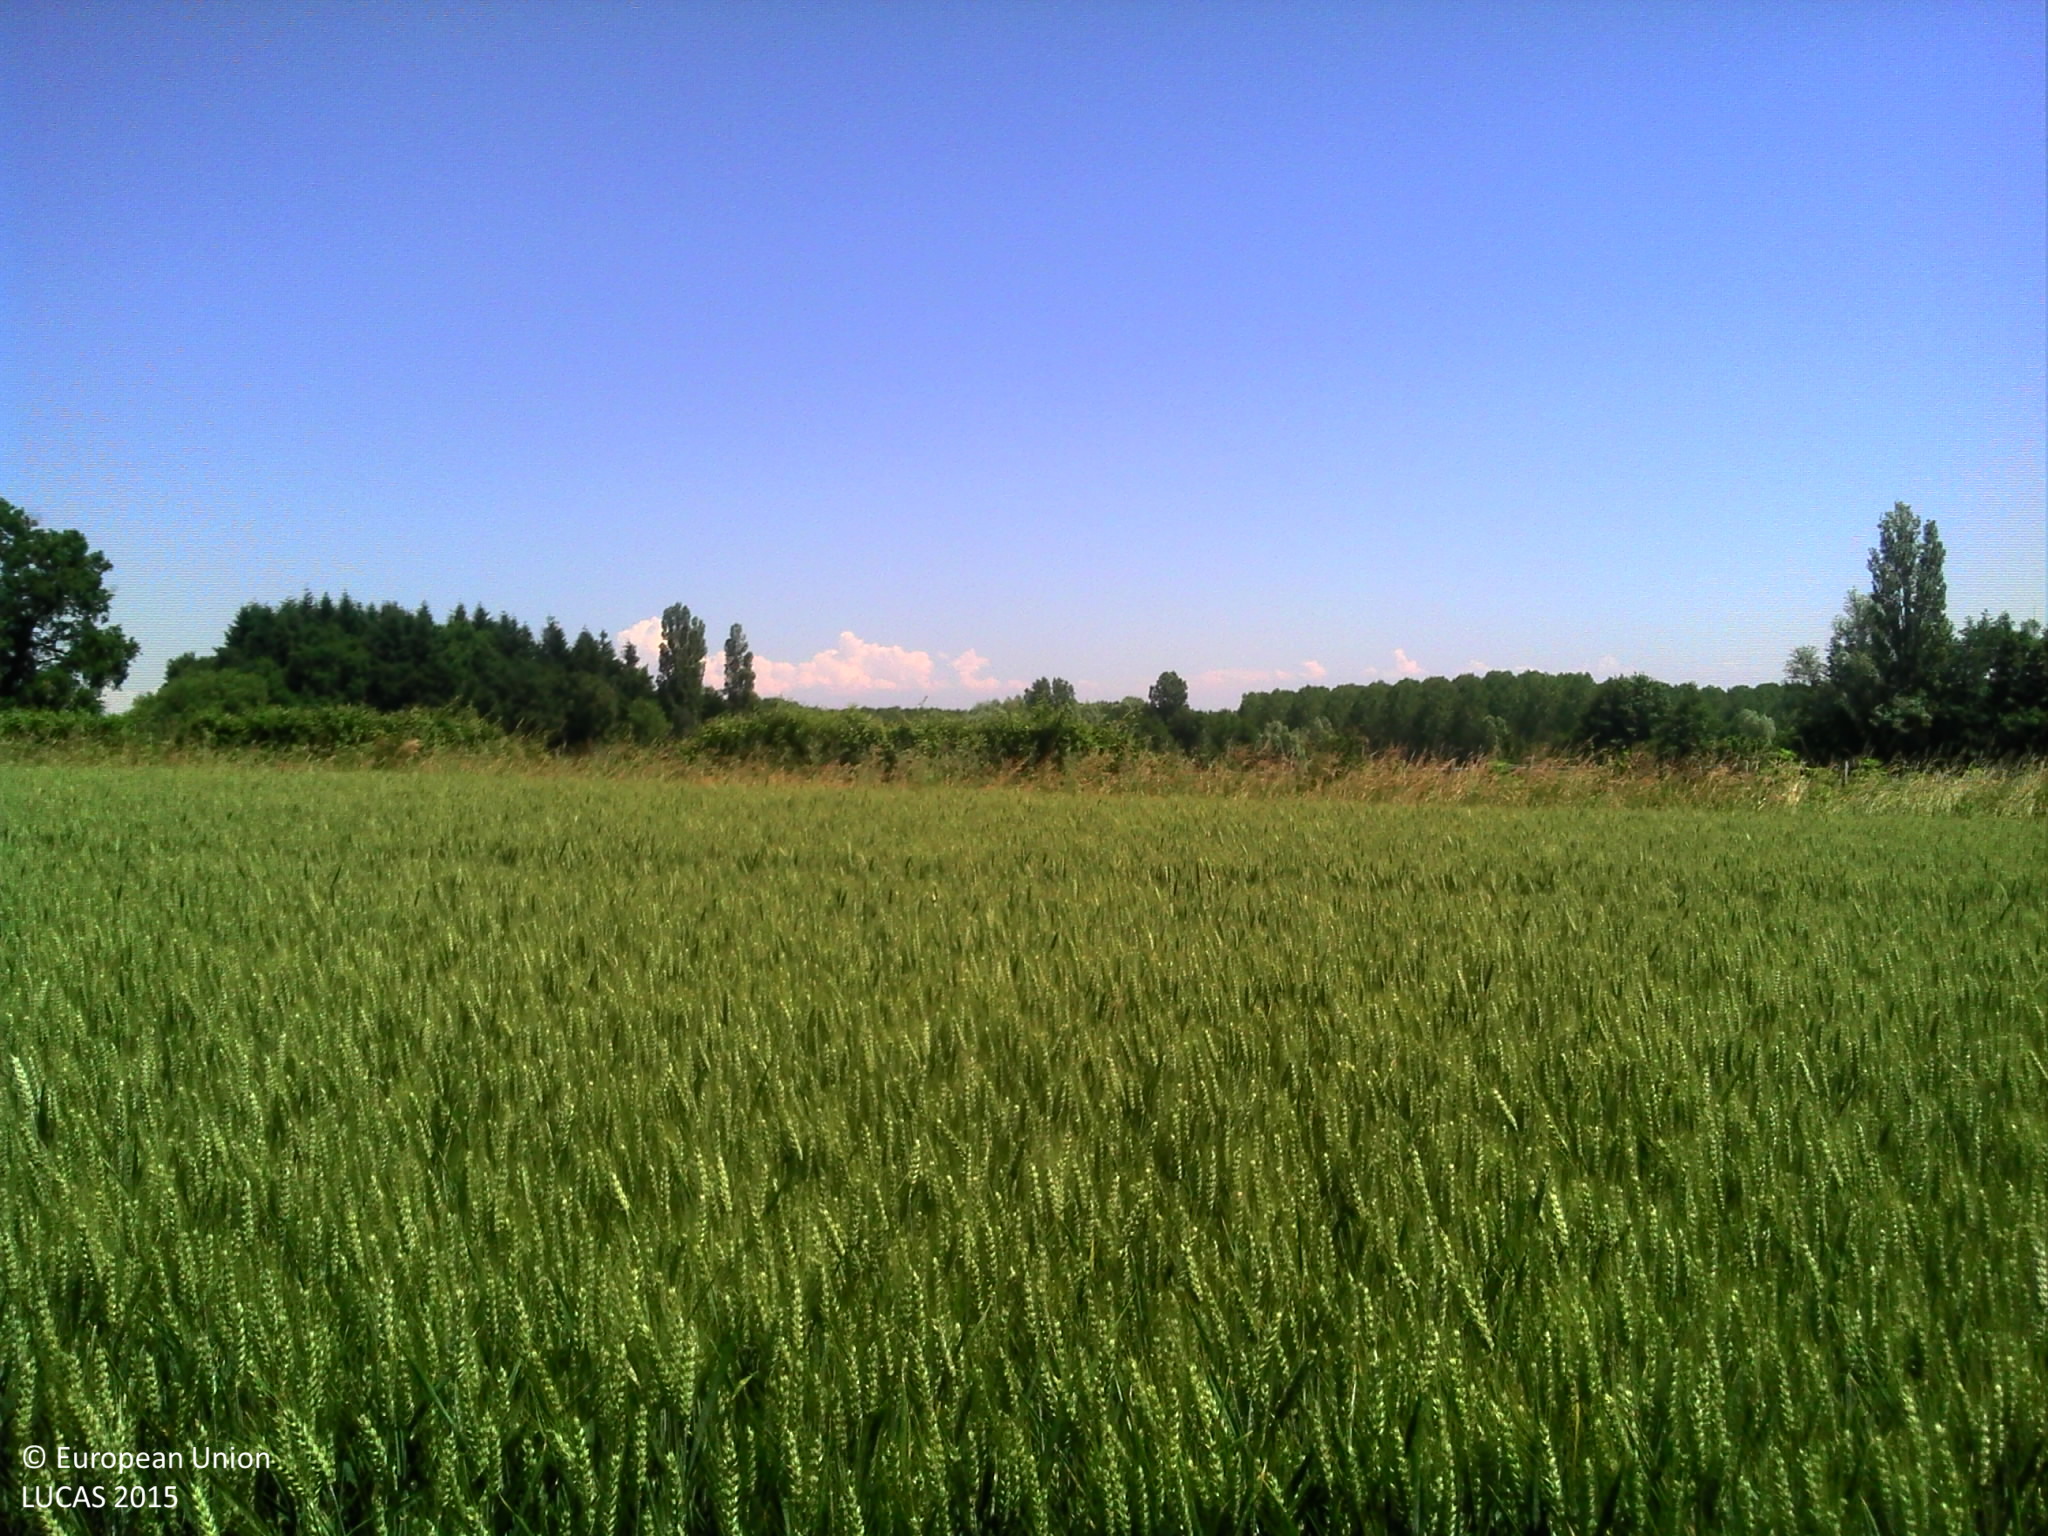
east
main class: Cropland
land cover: Common wheat
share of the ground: > 75 %
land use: Agriculture (excluding fallow land and kitchen gardens)
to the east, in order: Common wheat; Grass margins; Paved roads, cycling and walking lanes; Grass margins; Abandoned hedges; Fences; Grassland without tree/shrub cover; Abandoned hedges; Fences; Maize
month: June
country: FR
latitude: 46.5006
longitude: 4.9071
